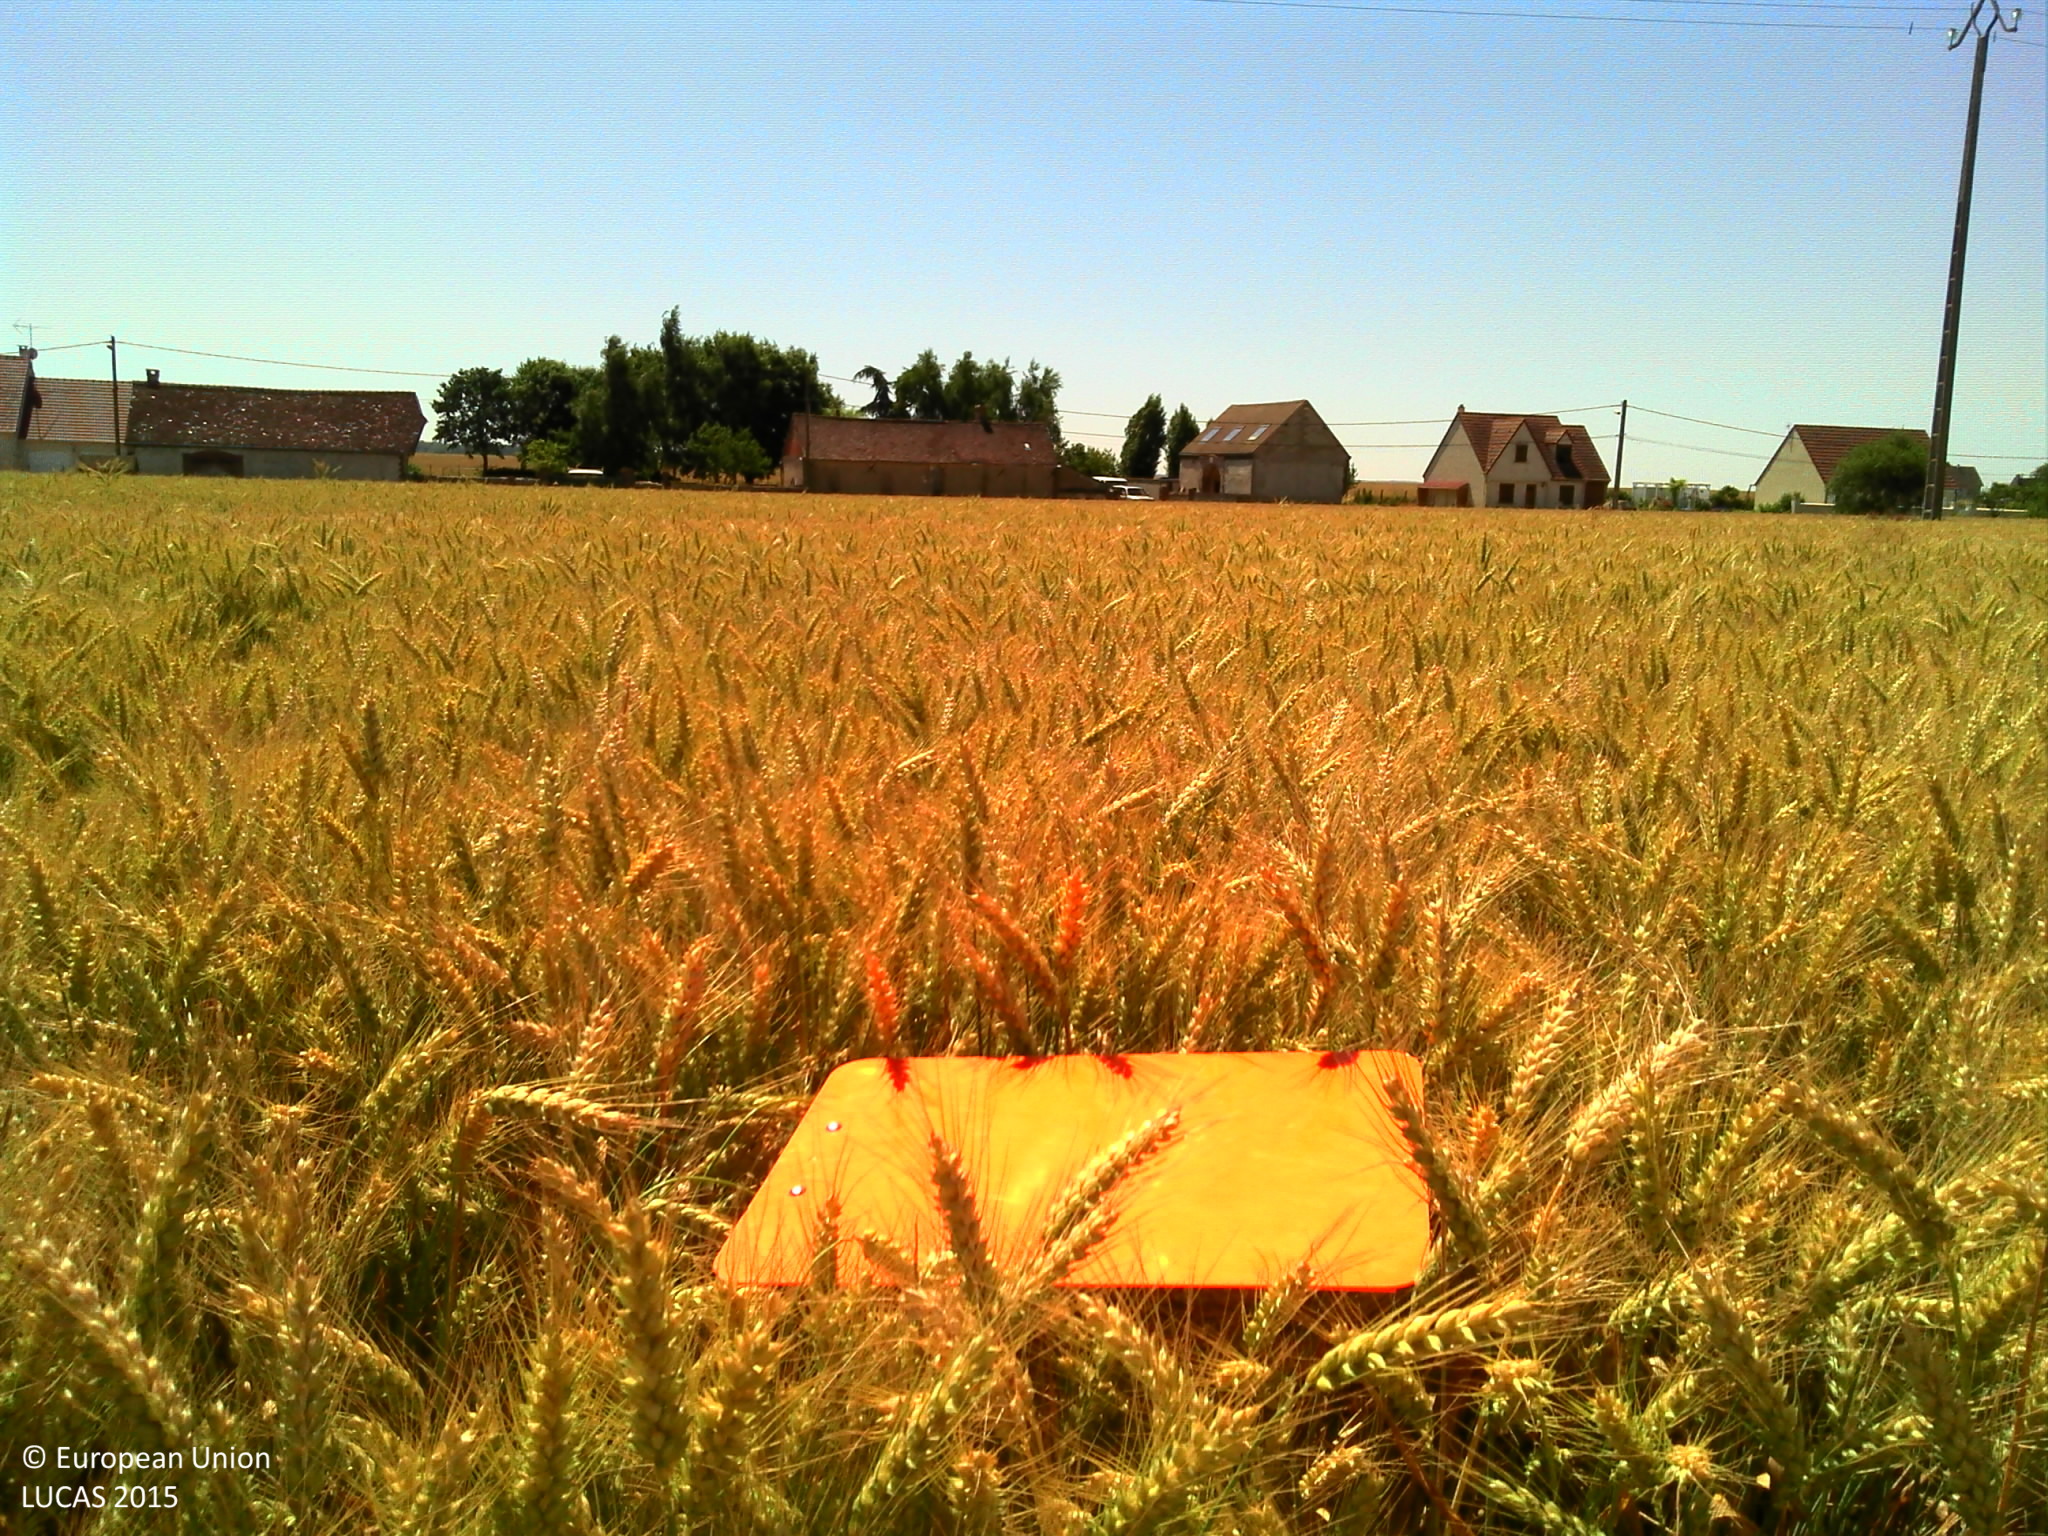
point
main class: Cropland
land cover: Common wheat
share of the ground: > 75 %
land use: Agriculture (excluding fallow land and kitchen gardens)
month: June
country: FR
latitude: 48.6849
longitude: 1.1922
